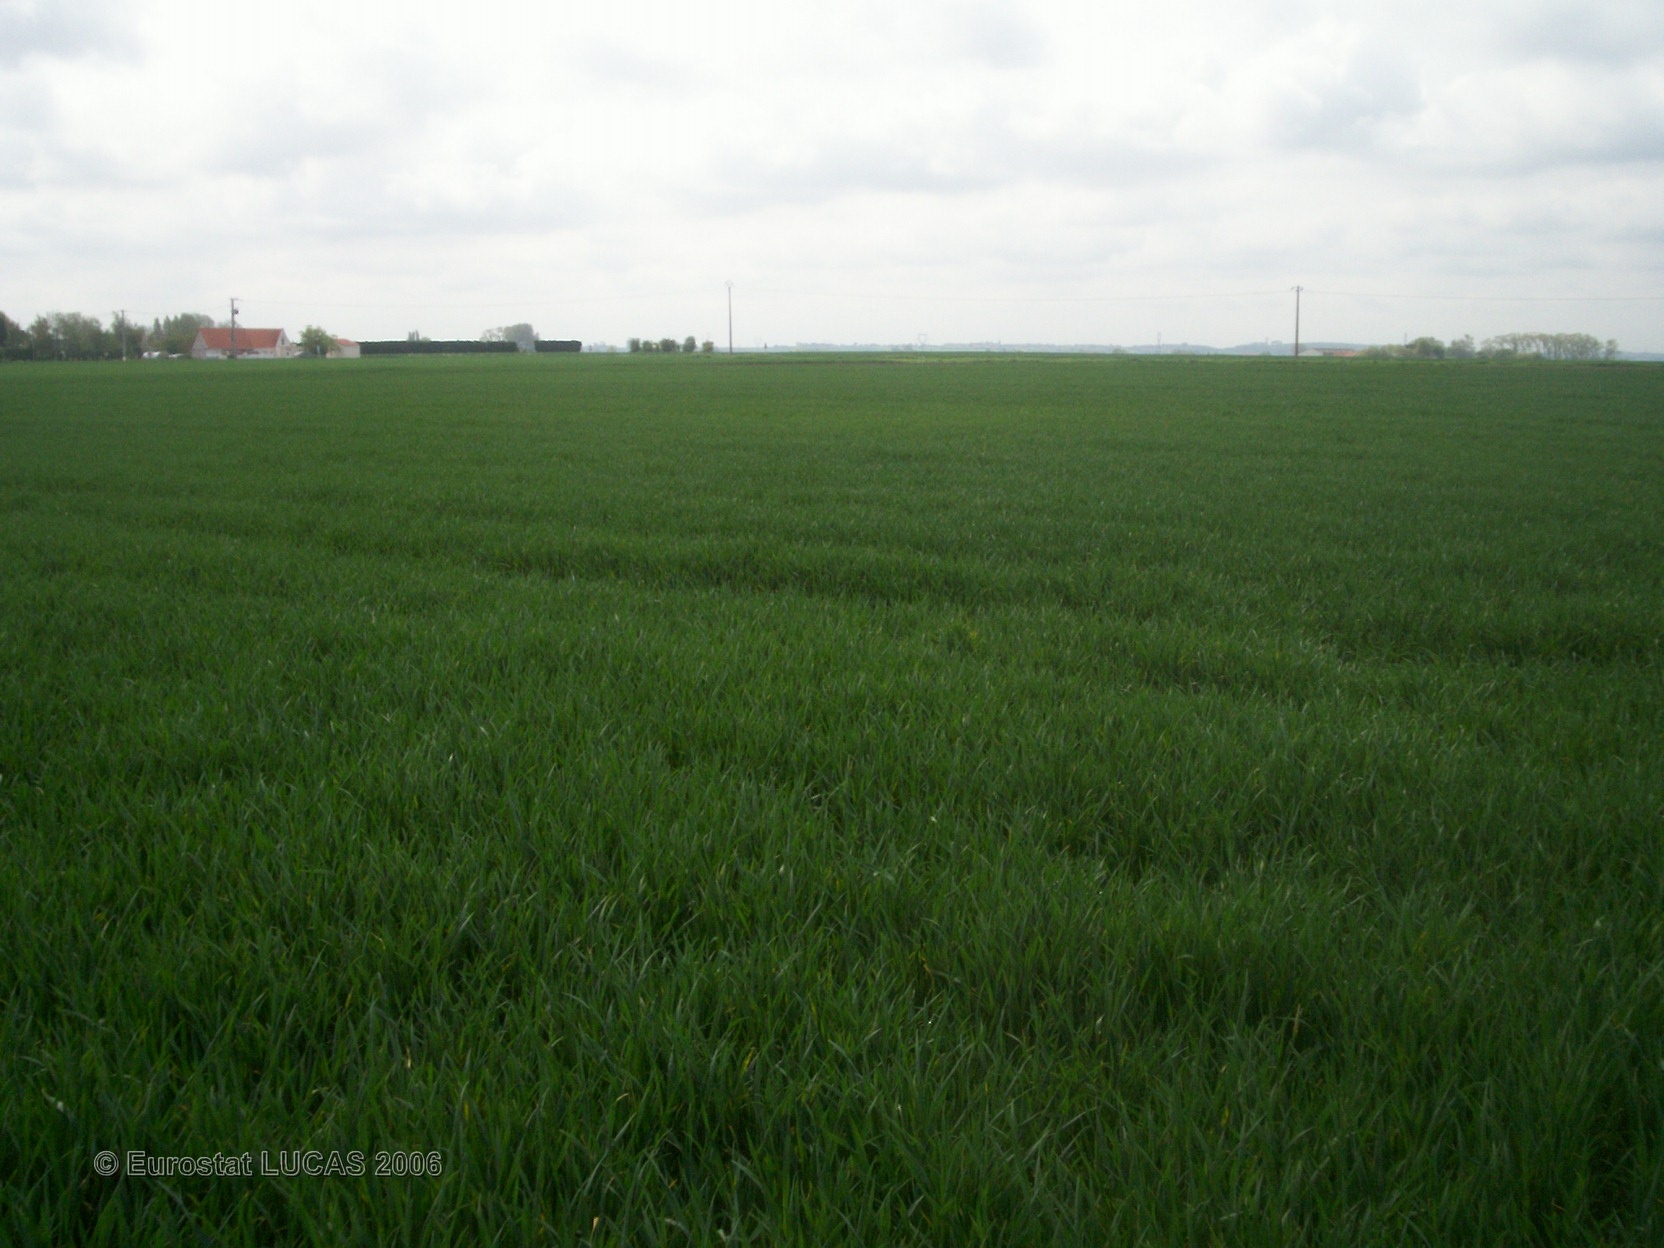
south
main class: Cropland
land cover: Common wheat
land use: Agriculture (excluding fallow land and kitchen gardens)
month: May
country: FR
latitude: 50.9165
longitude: 2.2907
